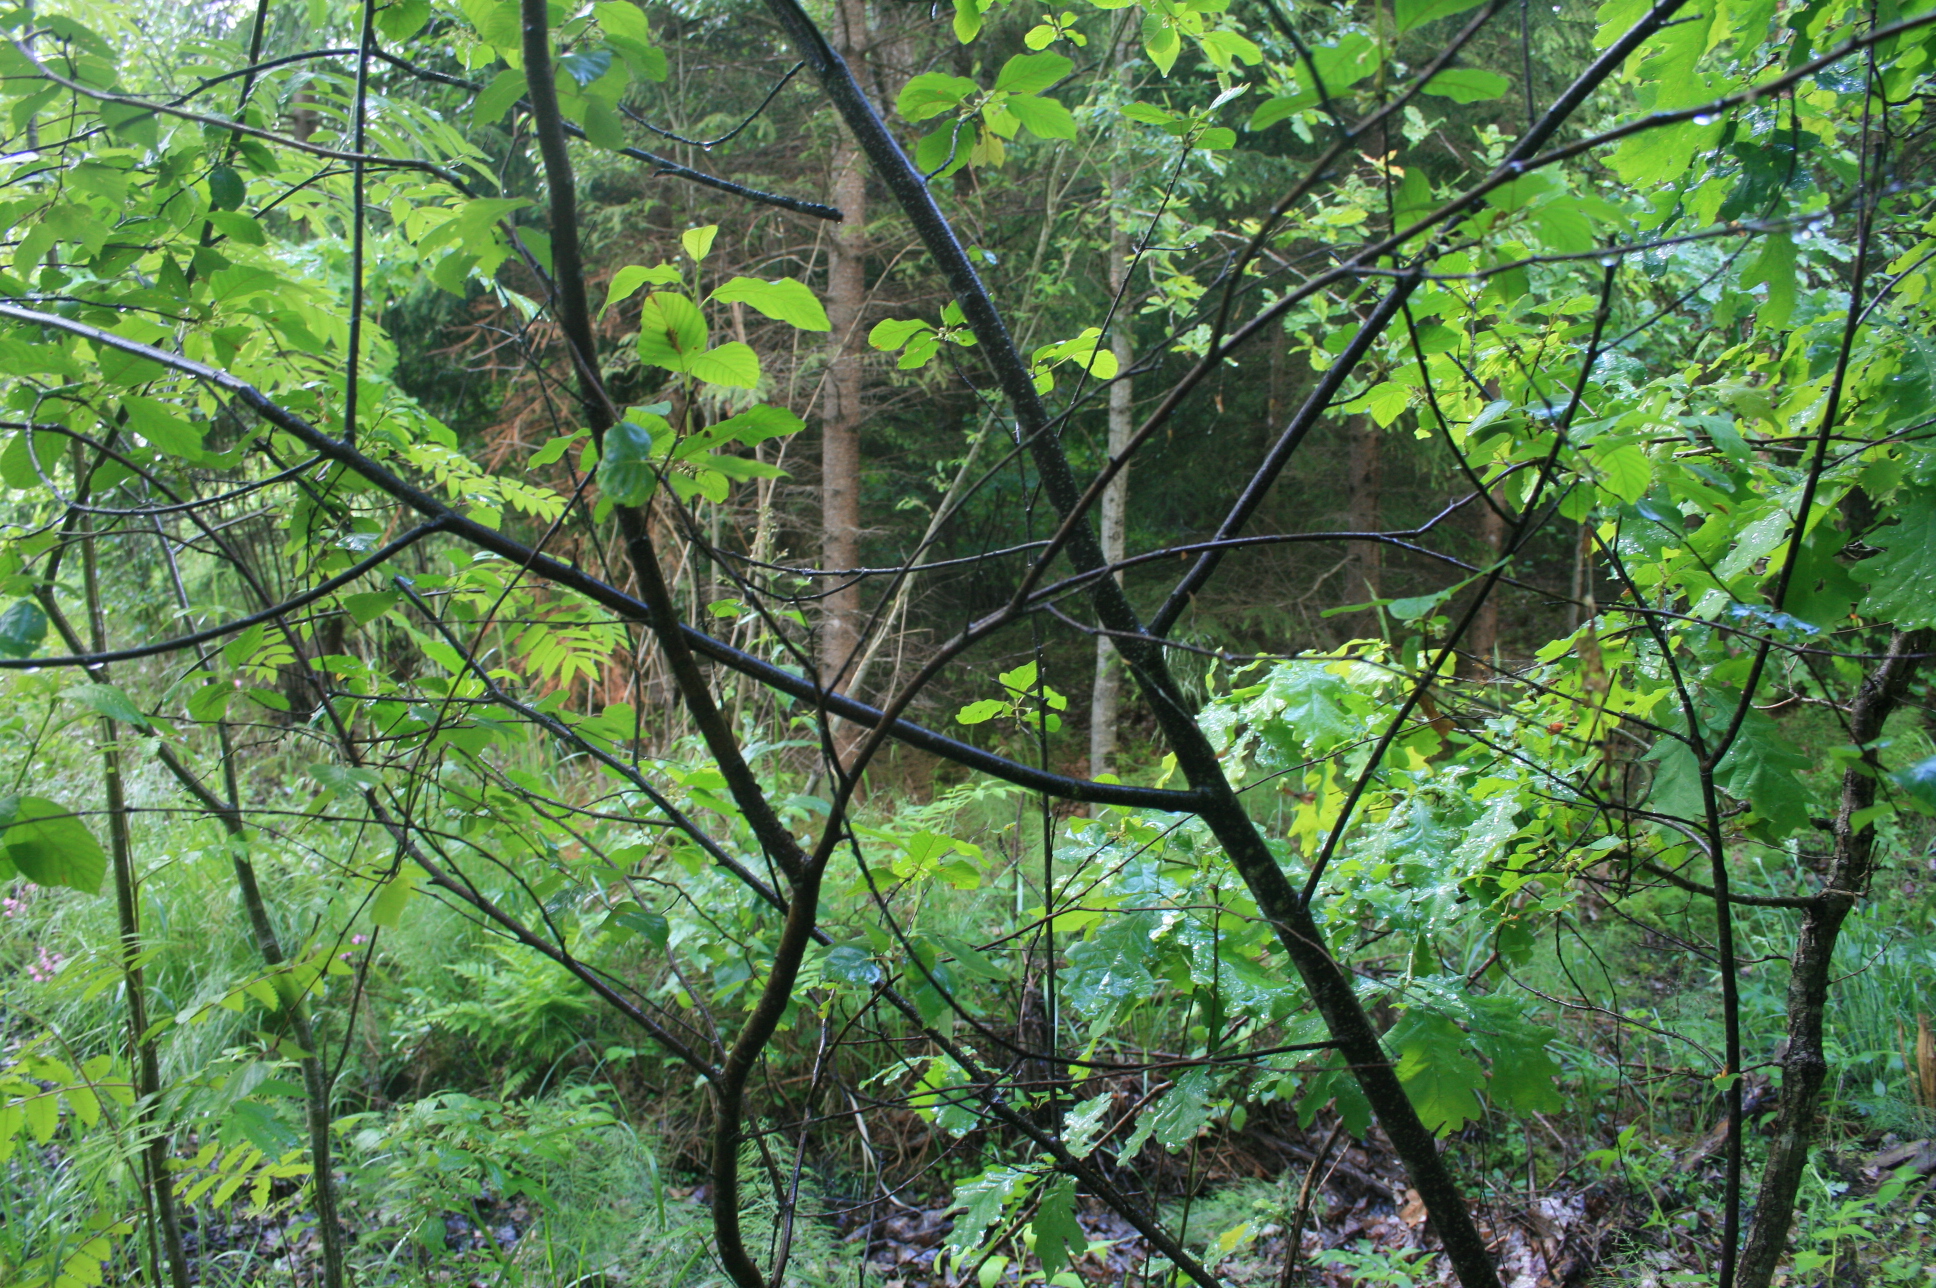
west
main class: Woodland
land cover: Spruce dominated mixed woodland
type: hemiboreal forest and nemoral coniferous forest and mixed broadleaved-coniferous forest
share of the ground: > 75 %
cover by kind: coniferous forest trees 45 %, broadleaved forest trees 35 %, herbaceous plants 20 %
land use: Forestry
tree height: > 5 m
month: June
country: LT
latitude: 55.3557
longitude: 22.1217
